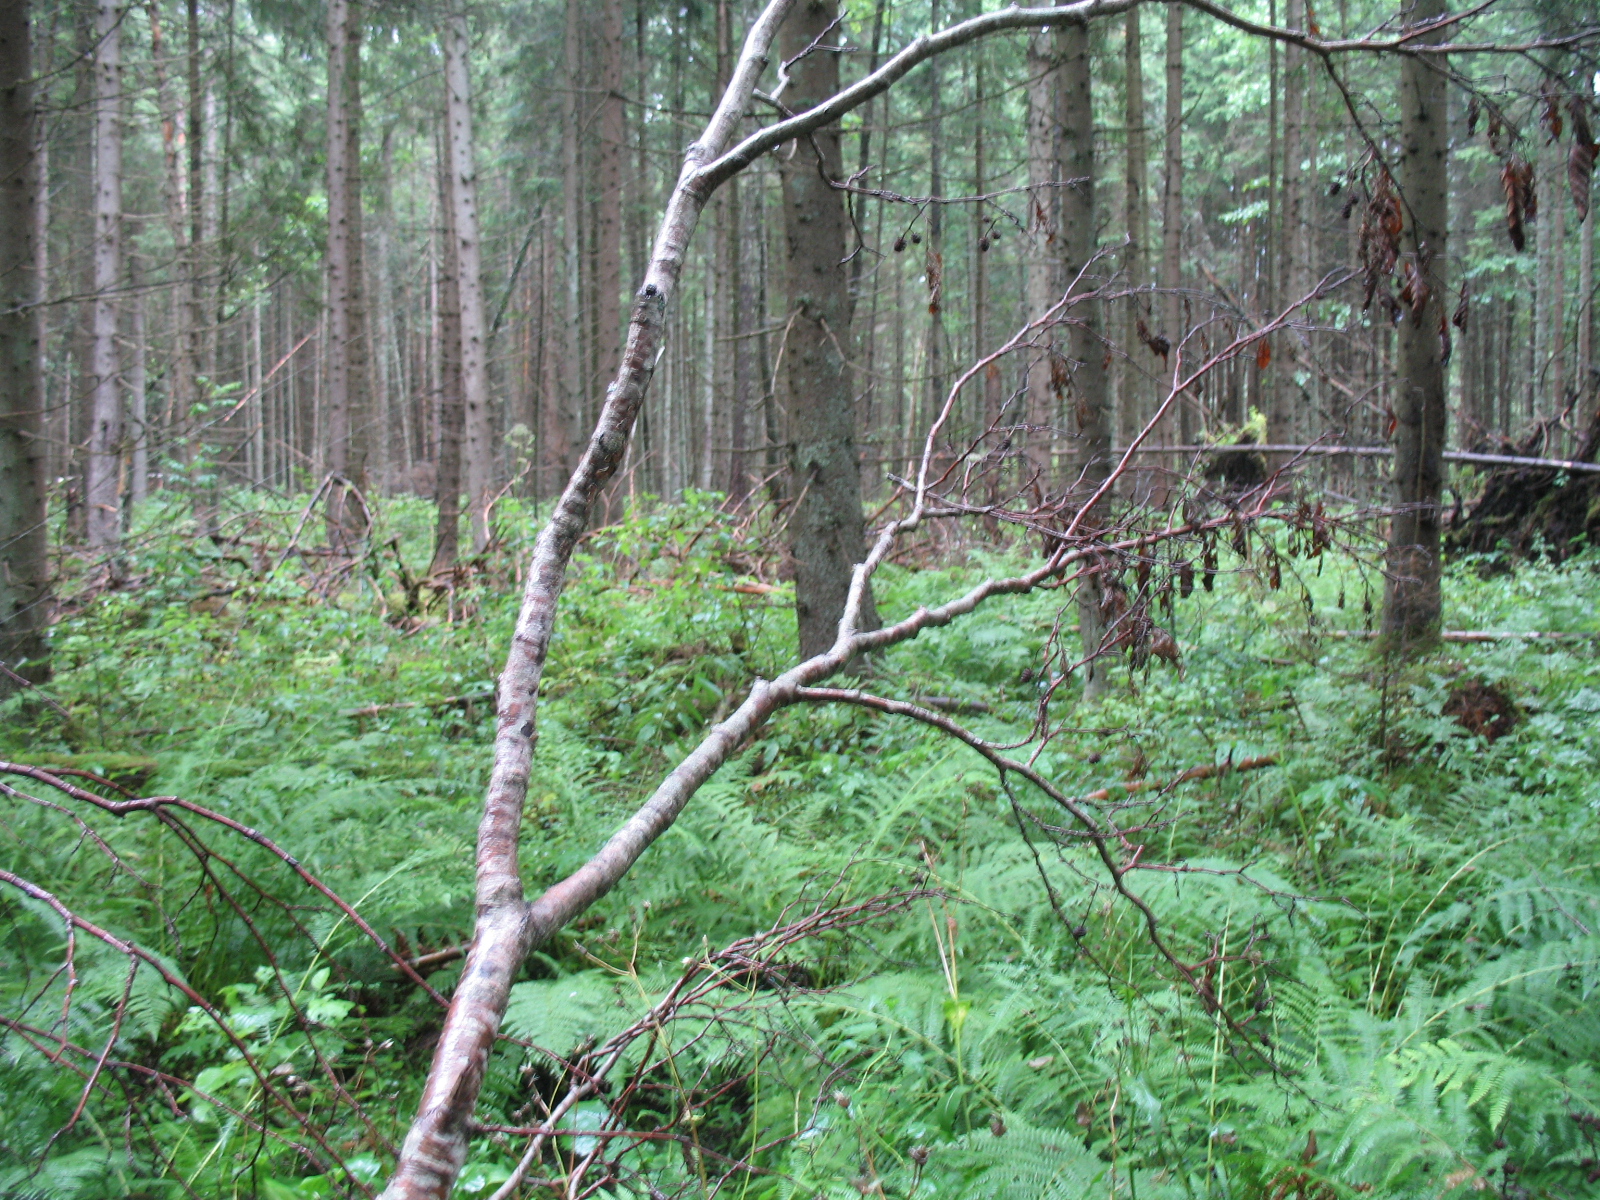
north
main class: Woodland
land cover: Spruce dominated mixed woodland
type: hemiboreal forest and nemoral coniferous forest and mixed broadleaved-coniferous forest
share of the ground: > 75 %
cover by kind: coniferous forest trees 40 %, broadleaved forest trees 40 %, herbaceous plants 20 %
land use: Forestry
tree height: > 5 m
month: July
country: LV
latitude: 56.4576
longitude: 25.1209
